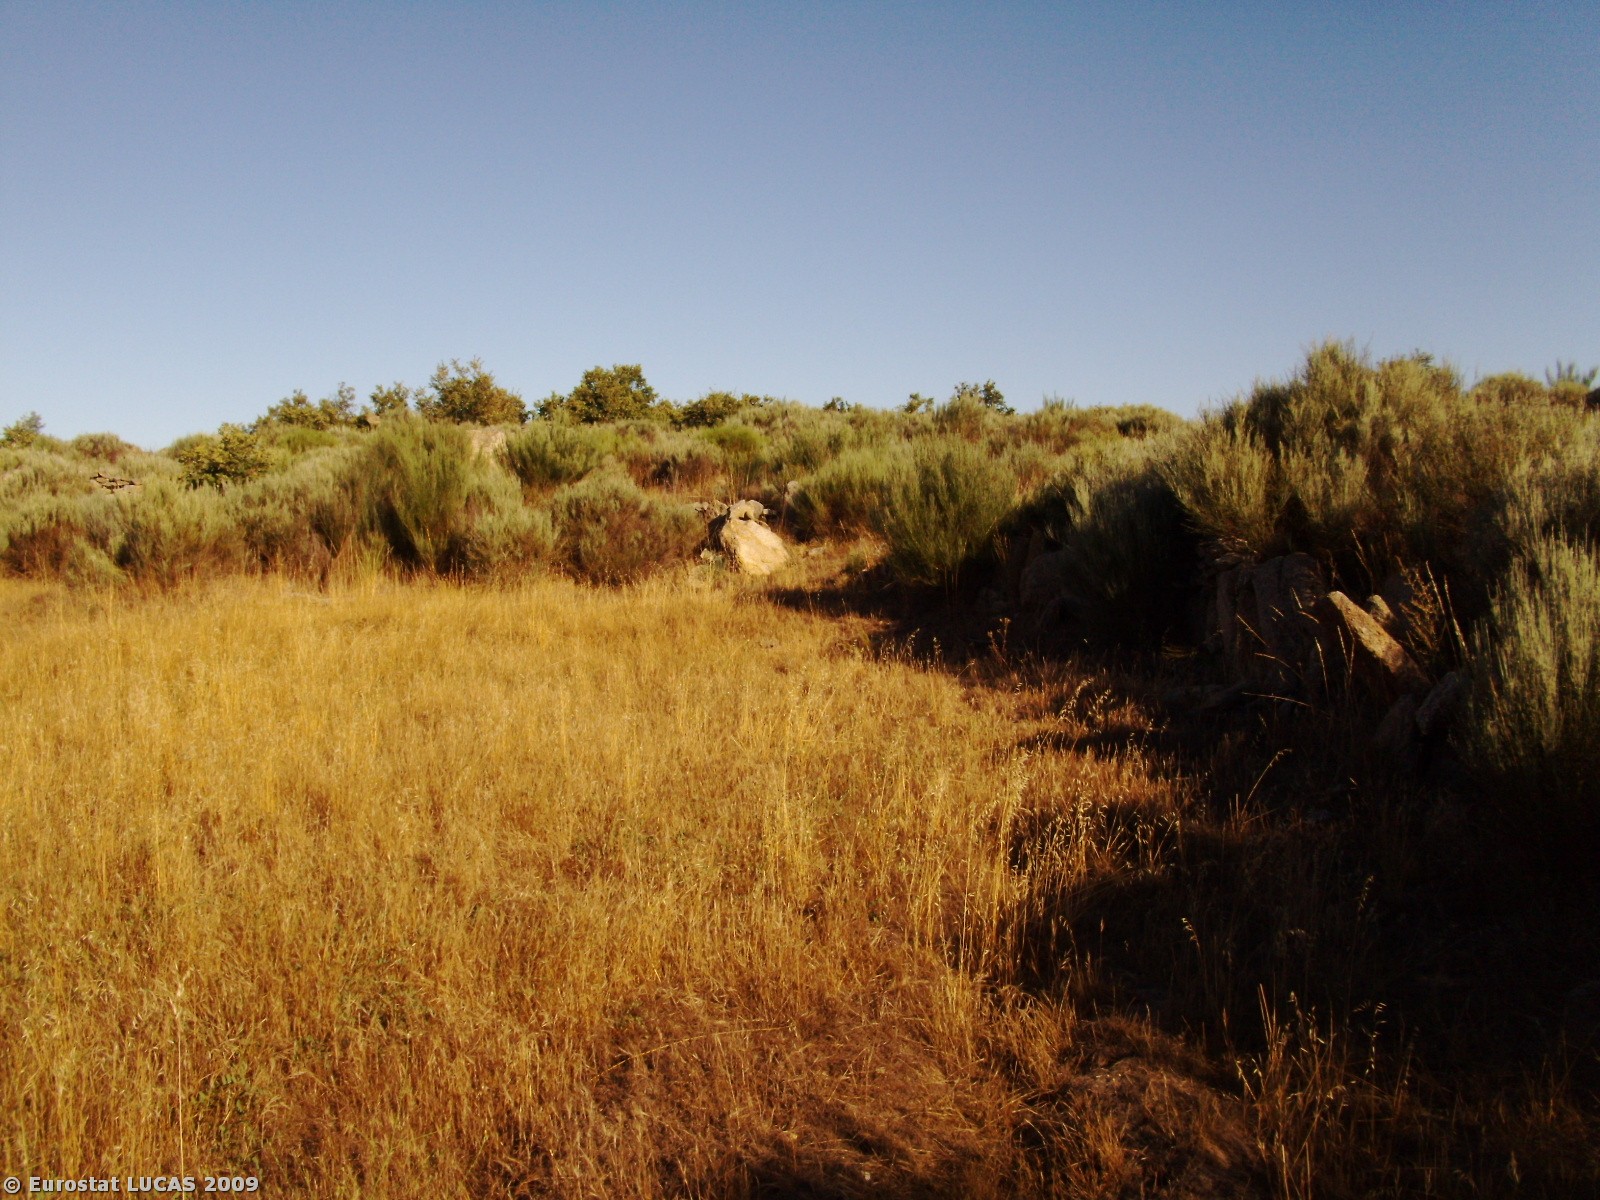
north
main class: Shrubland
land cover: Shrubland without tree cover
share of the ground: > 75 %
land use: Unused
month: July
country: PT
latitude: 40.5827
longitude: -7.0792
